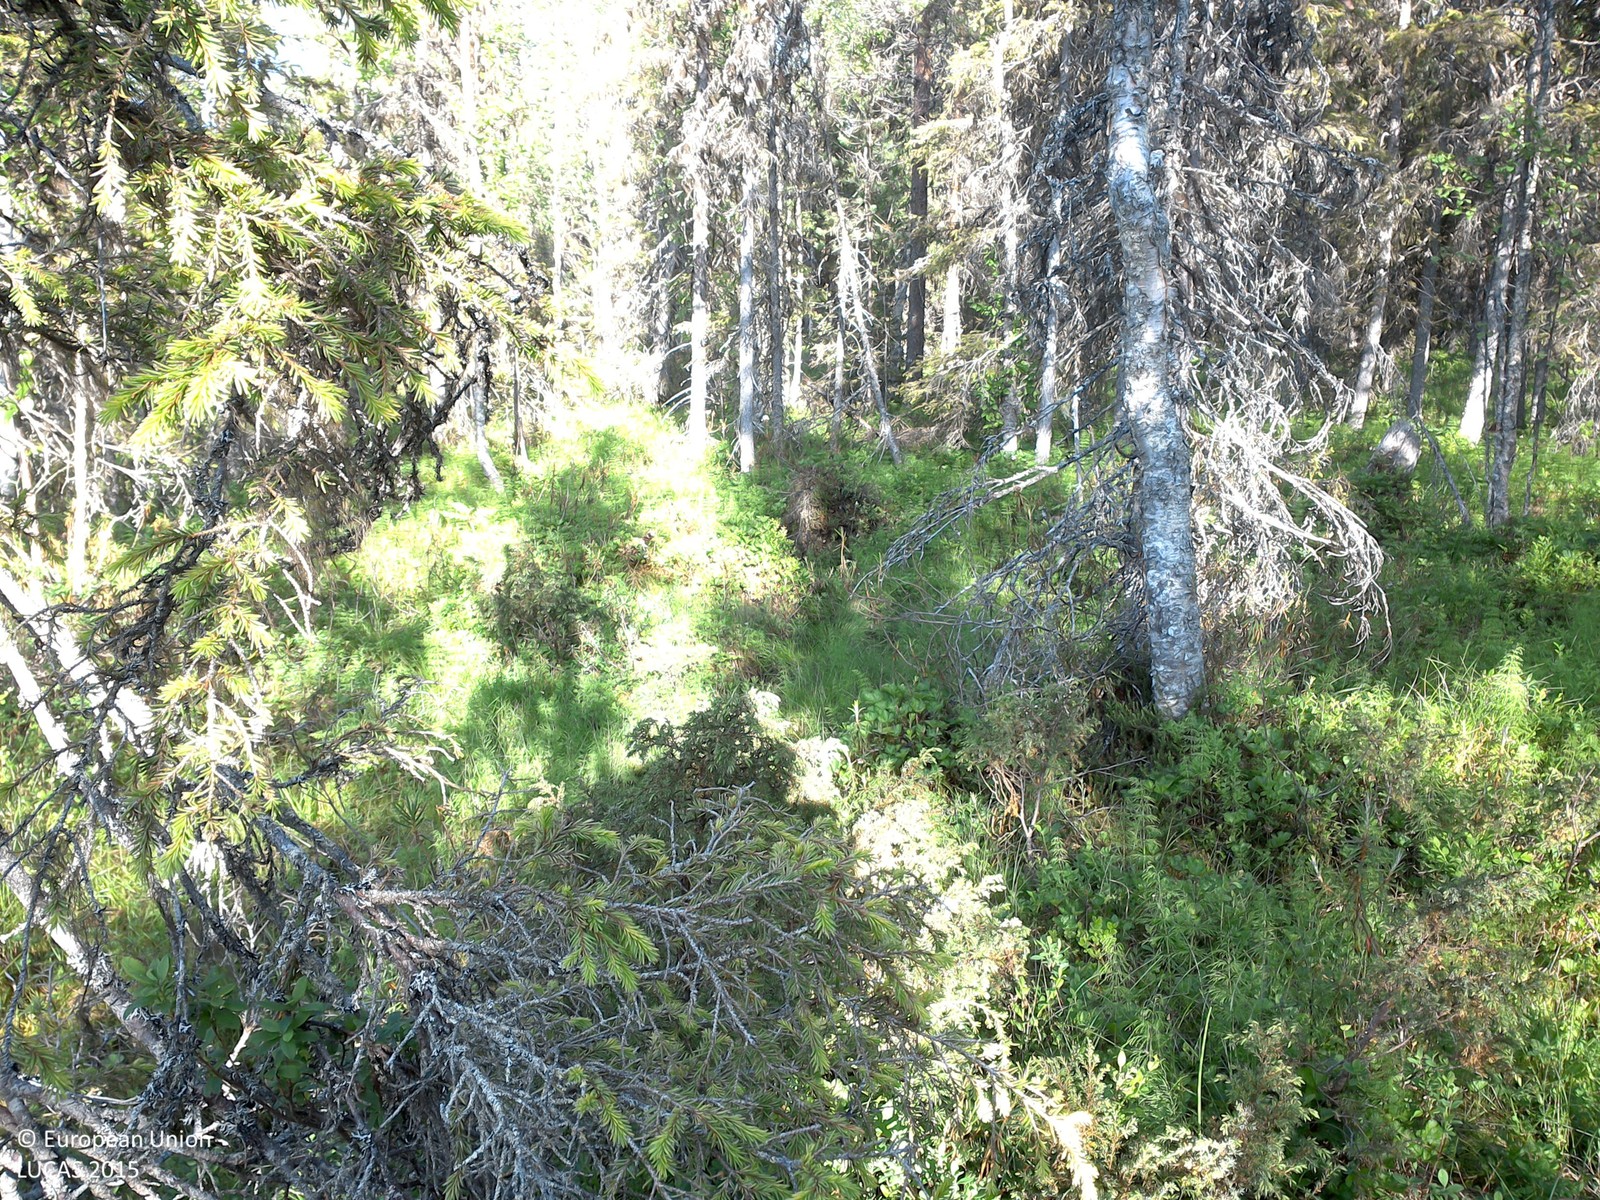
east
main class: Woodland
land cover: Spruce dominated mixed woodland
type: boreal forest
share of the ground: 10 - 25 %
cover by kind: herbaceous plants 35 %, shrubs 30 %, coniferous forest trees 15 %, lichens and mosses 15 %, broadleaved forest trees 5 %
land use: Forestry
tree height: > 5 m
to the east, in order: Spruce dominated mixed woodland; Shrubland with sparse tree cover; Spruce dominated mixed woodland; Peatbogs
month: July
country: SE
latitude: 66.7211
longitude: 23.5641
